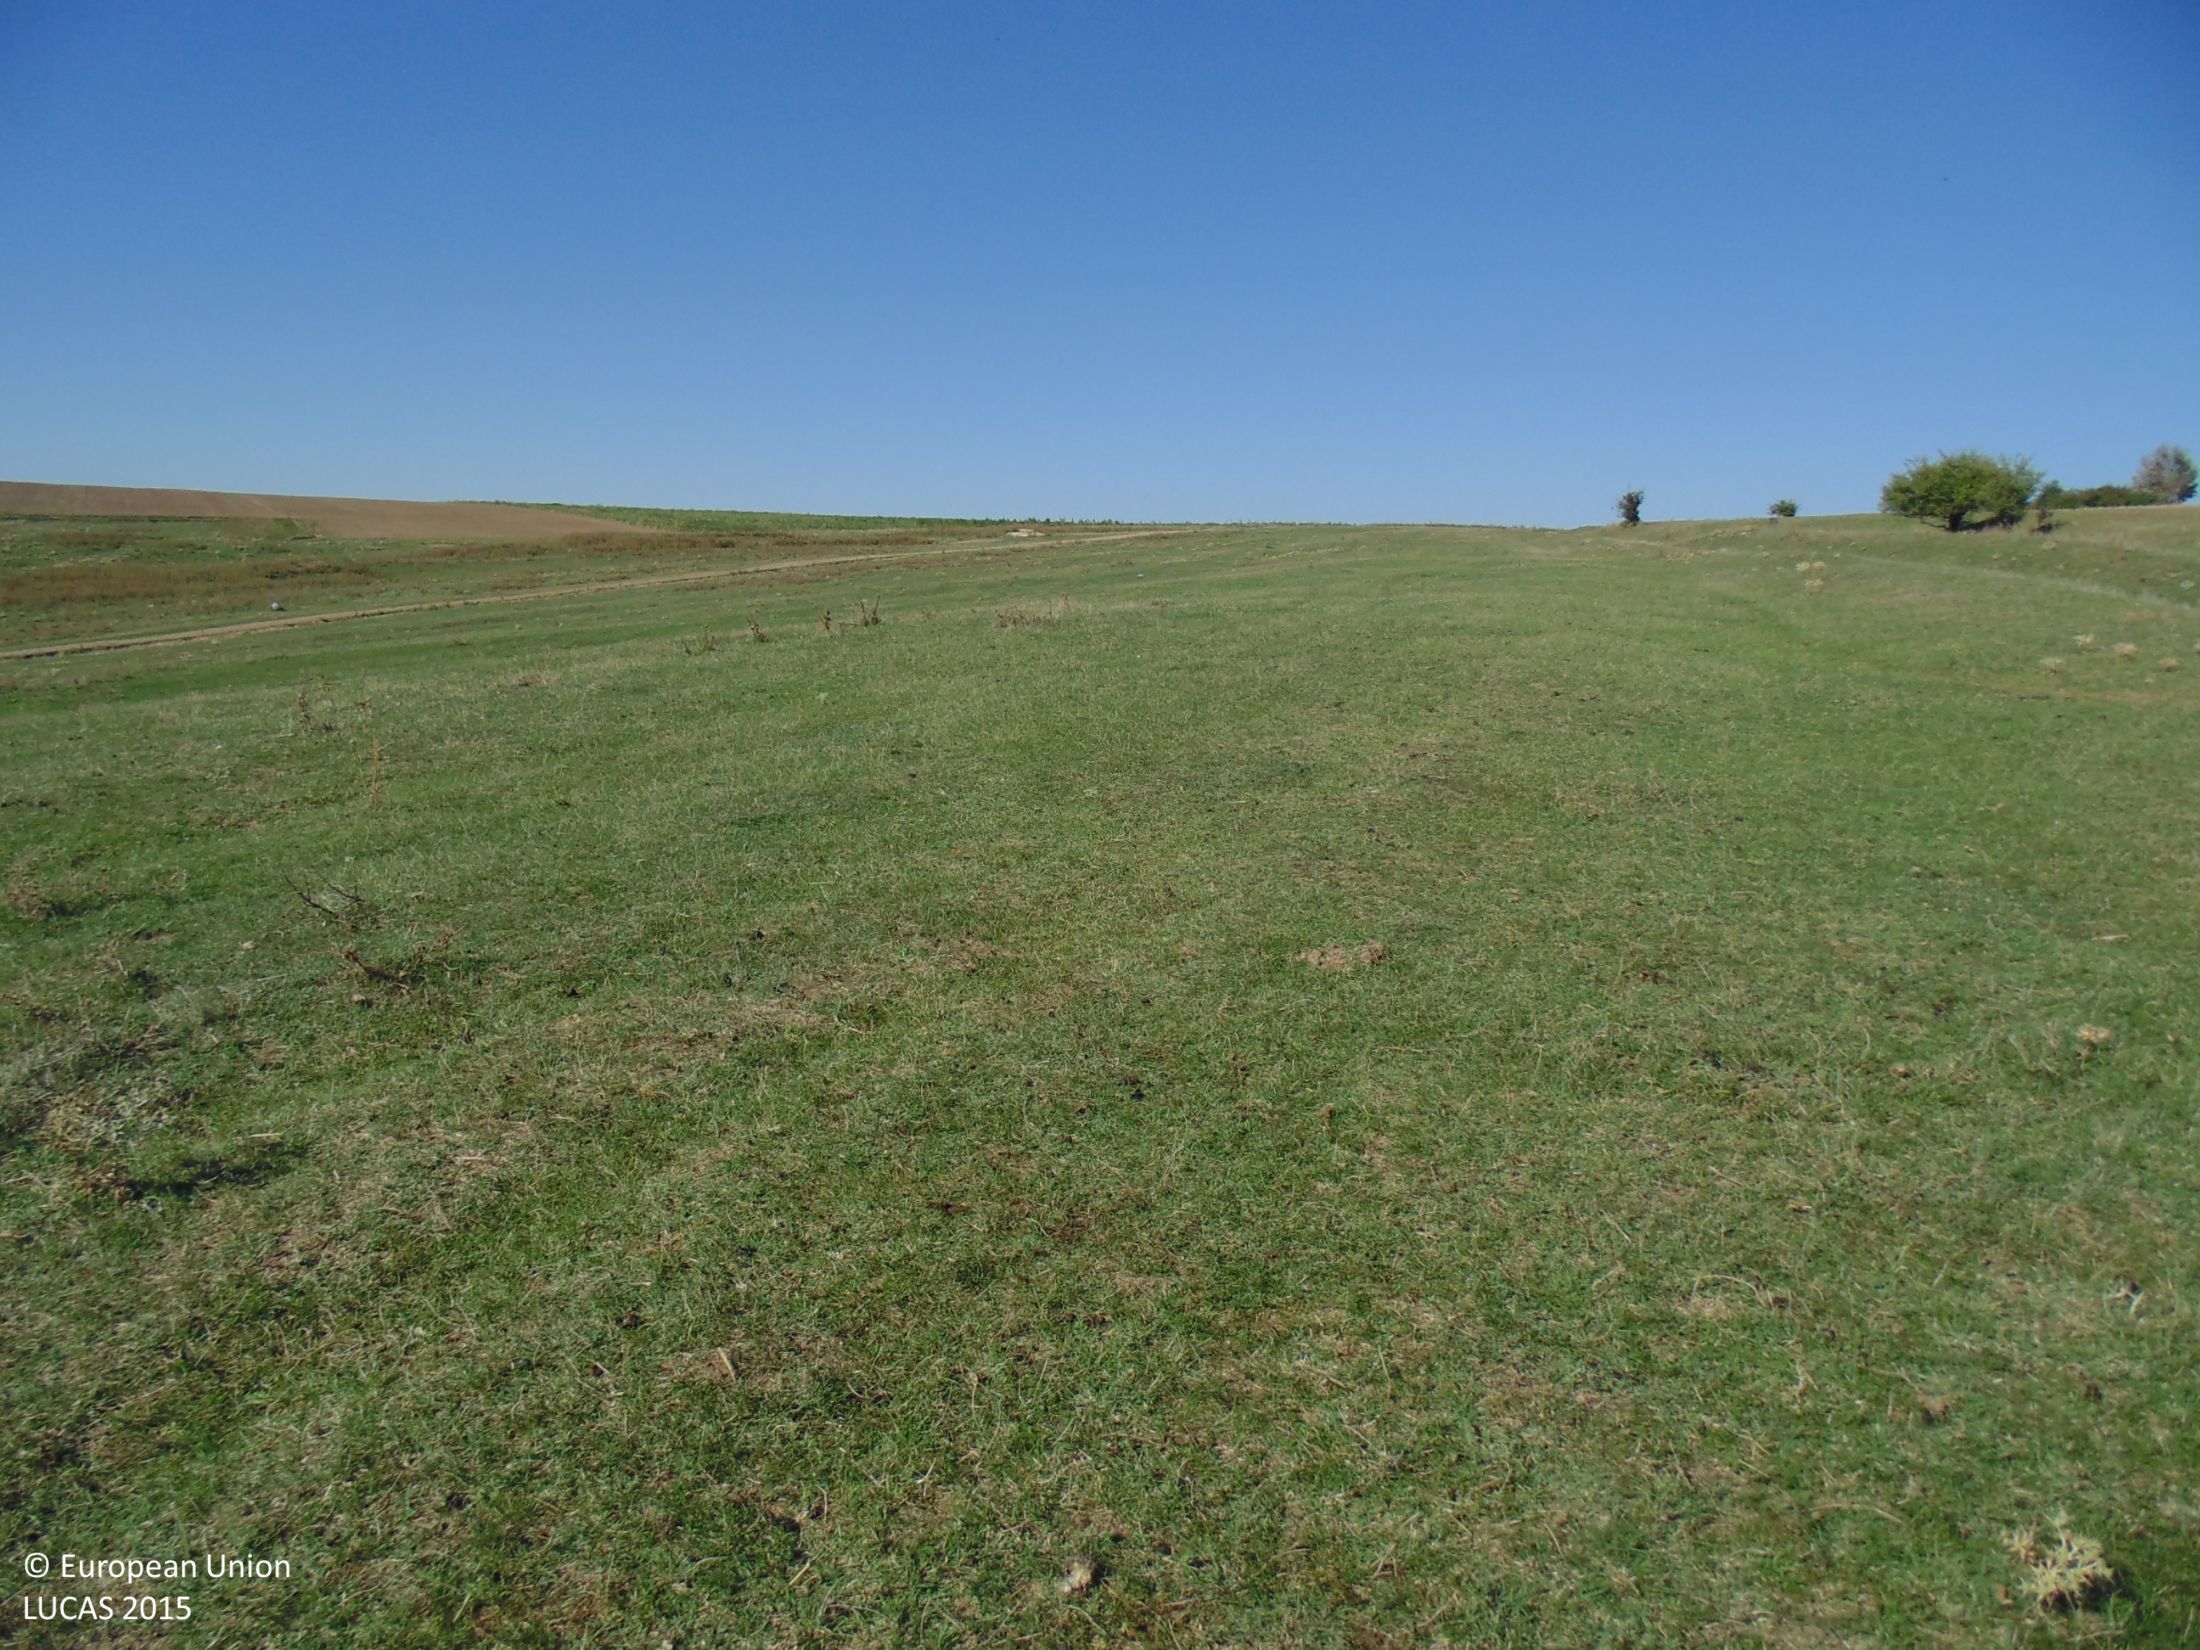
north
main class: Grassland
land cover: Grassland without tree/shrub cover
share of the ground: > 75 %
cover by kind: herbaceous plants 100 %
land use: Agriculture (excluding fallow land and kitchen gardens)
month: September
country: BG
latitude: 43.7251
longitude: 27.1176
